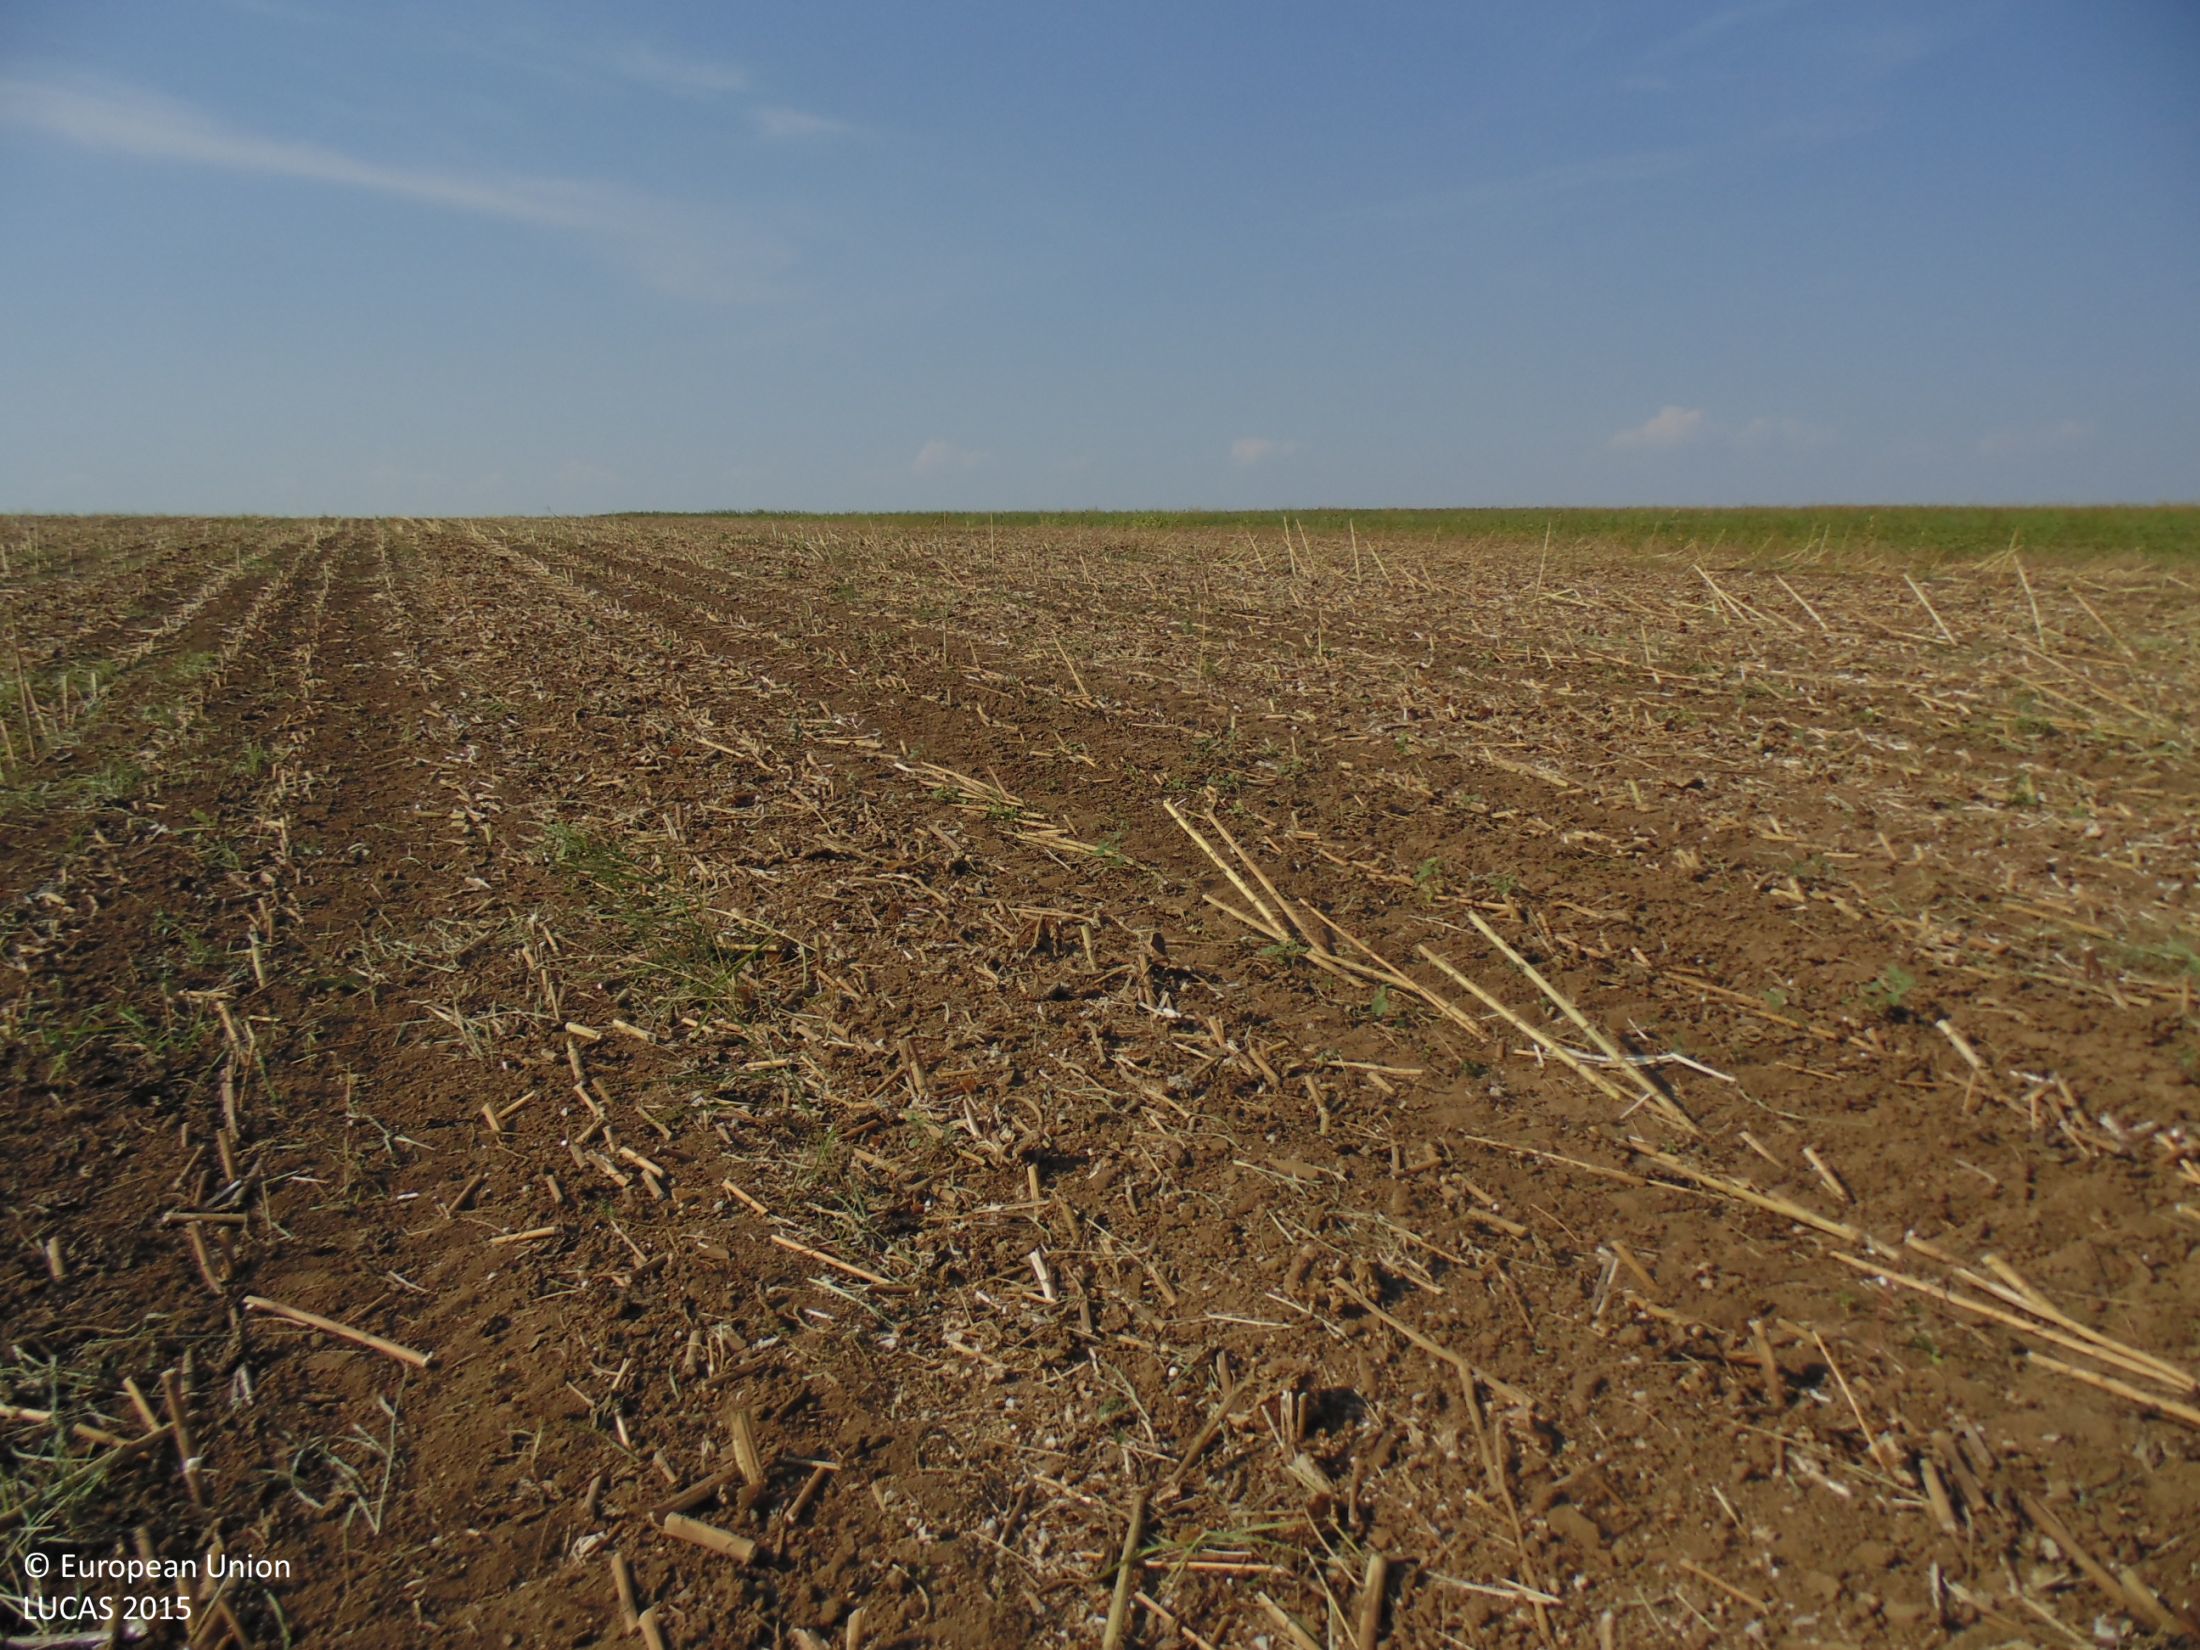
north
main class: Cropland
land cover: Sunflower
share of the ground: < 10 %
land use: Agriculture (excluding fallow land and kitchen gardens)
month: August
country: BG
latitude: 43.9579
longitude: 27.2654
